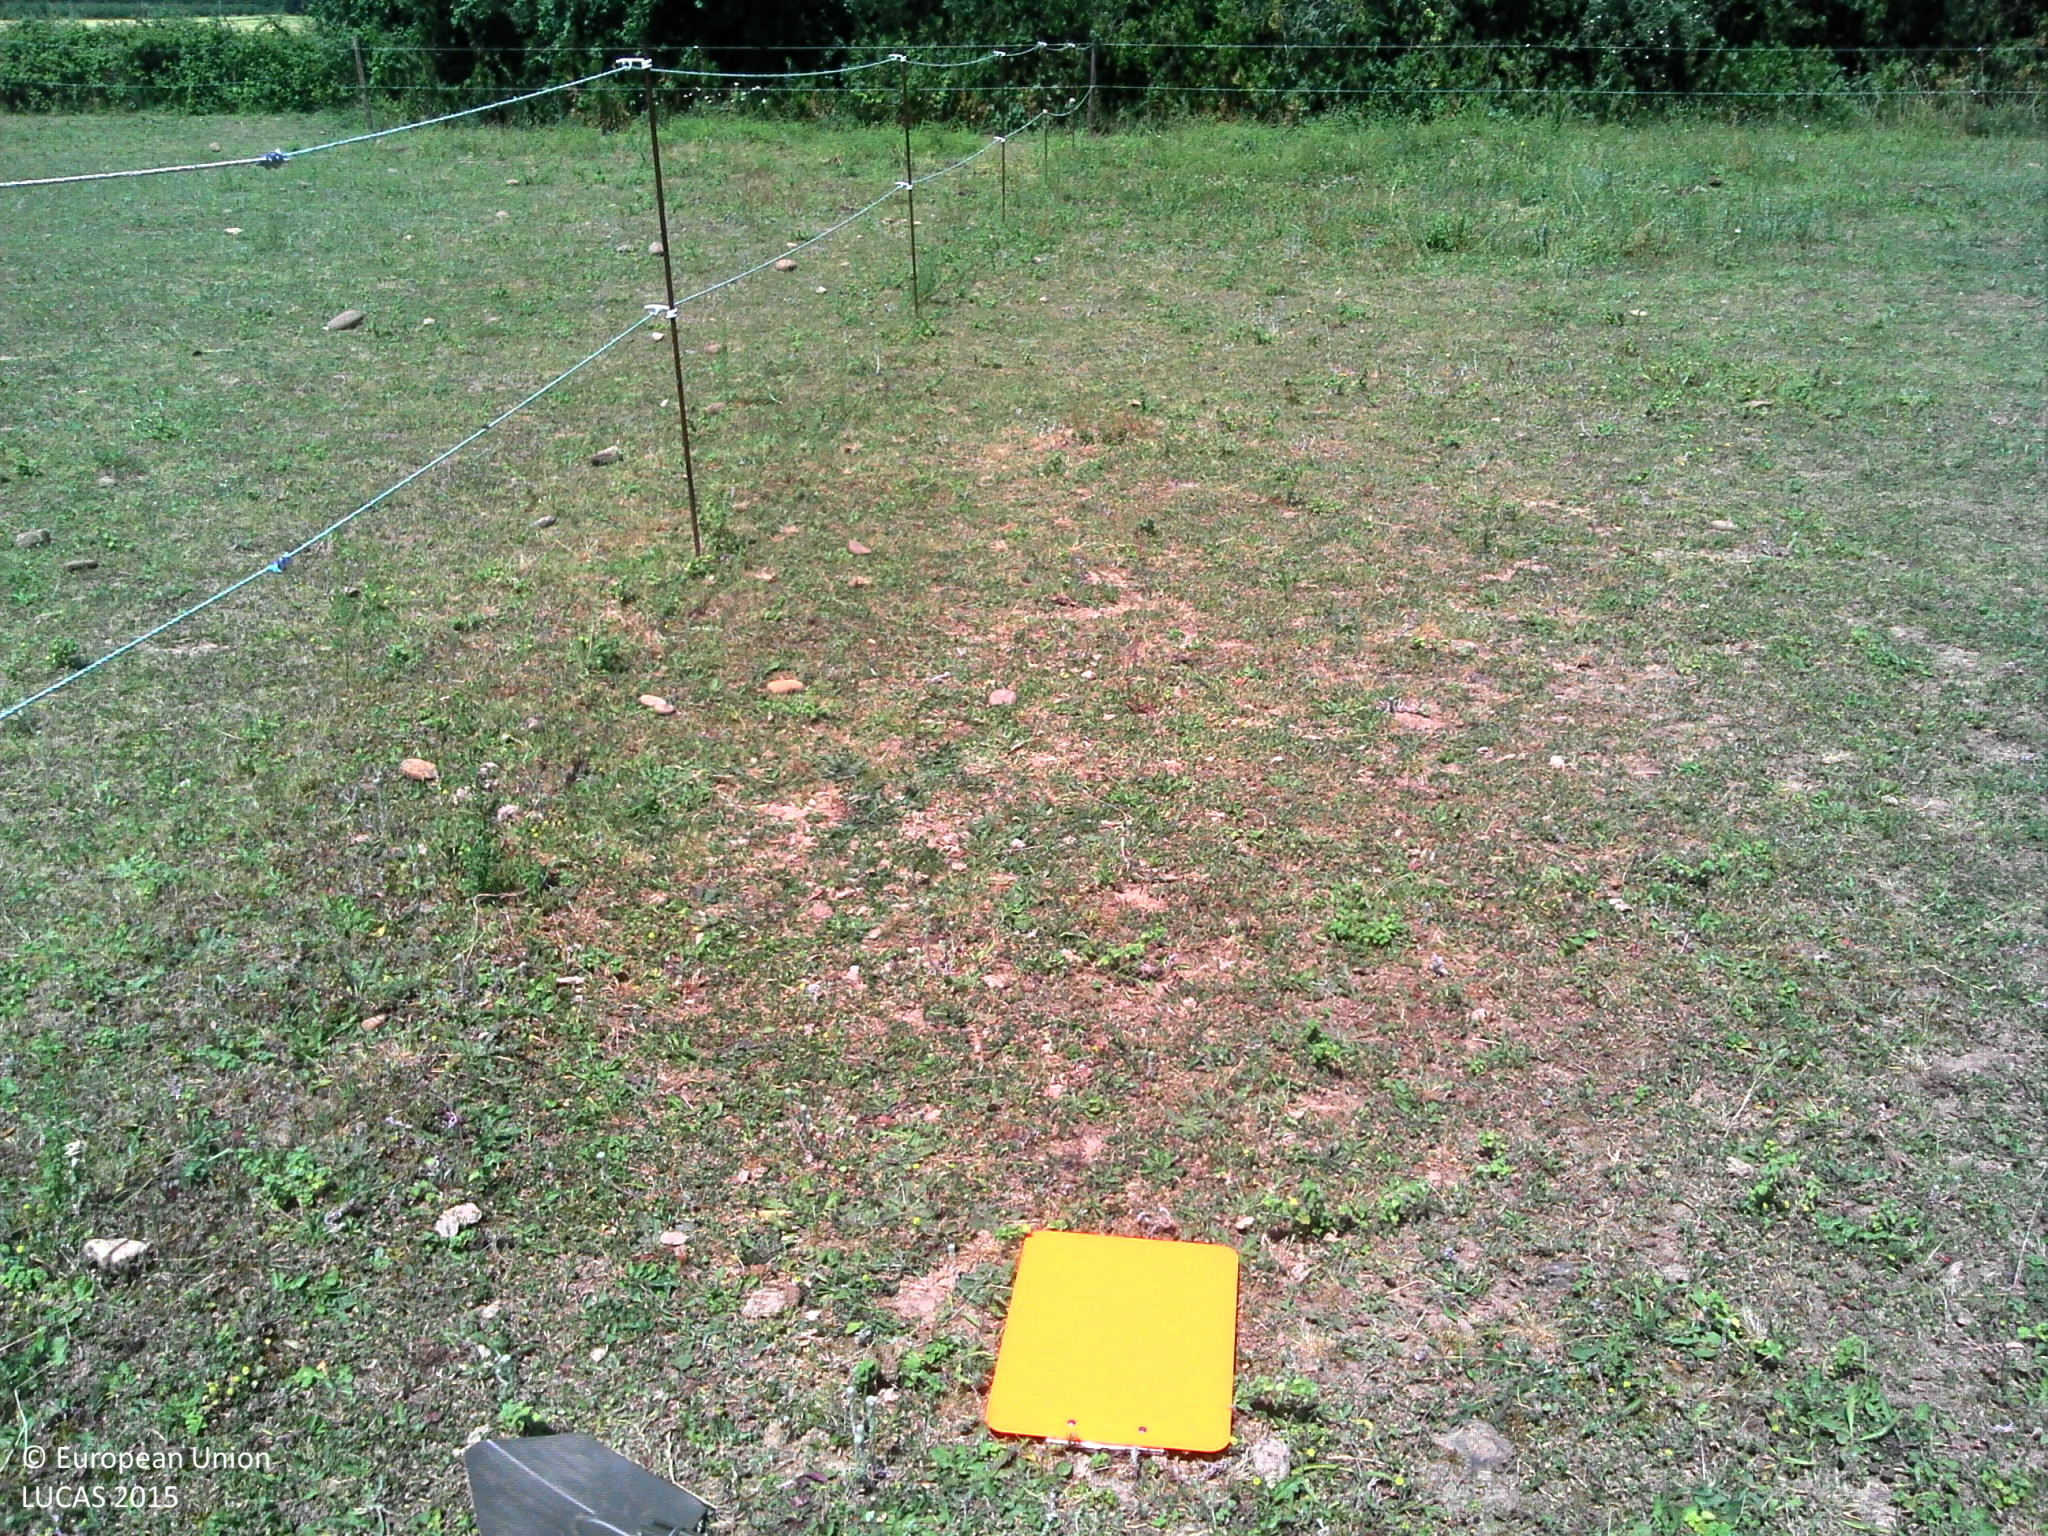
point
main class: Grassland
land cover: Grassland without tree/shrub cover
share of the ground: > 75 %
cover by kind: herbaceous plants 100 %
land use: Agriculture (excluding fallow land and kitchen gardens)
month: May
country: FR
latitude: 44.8770
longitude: 4.9297
